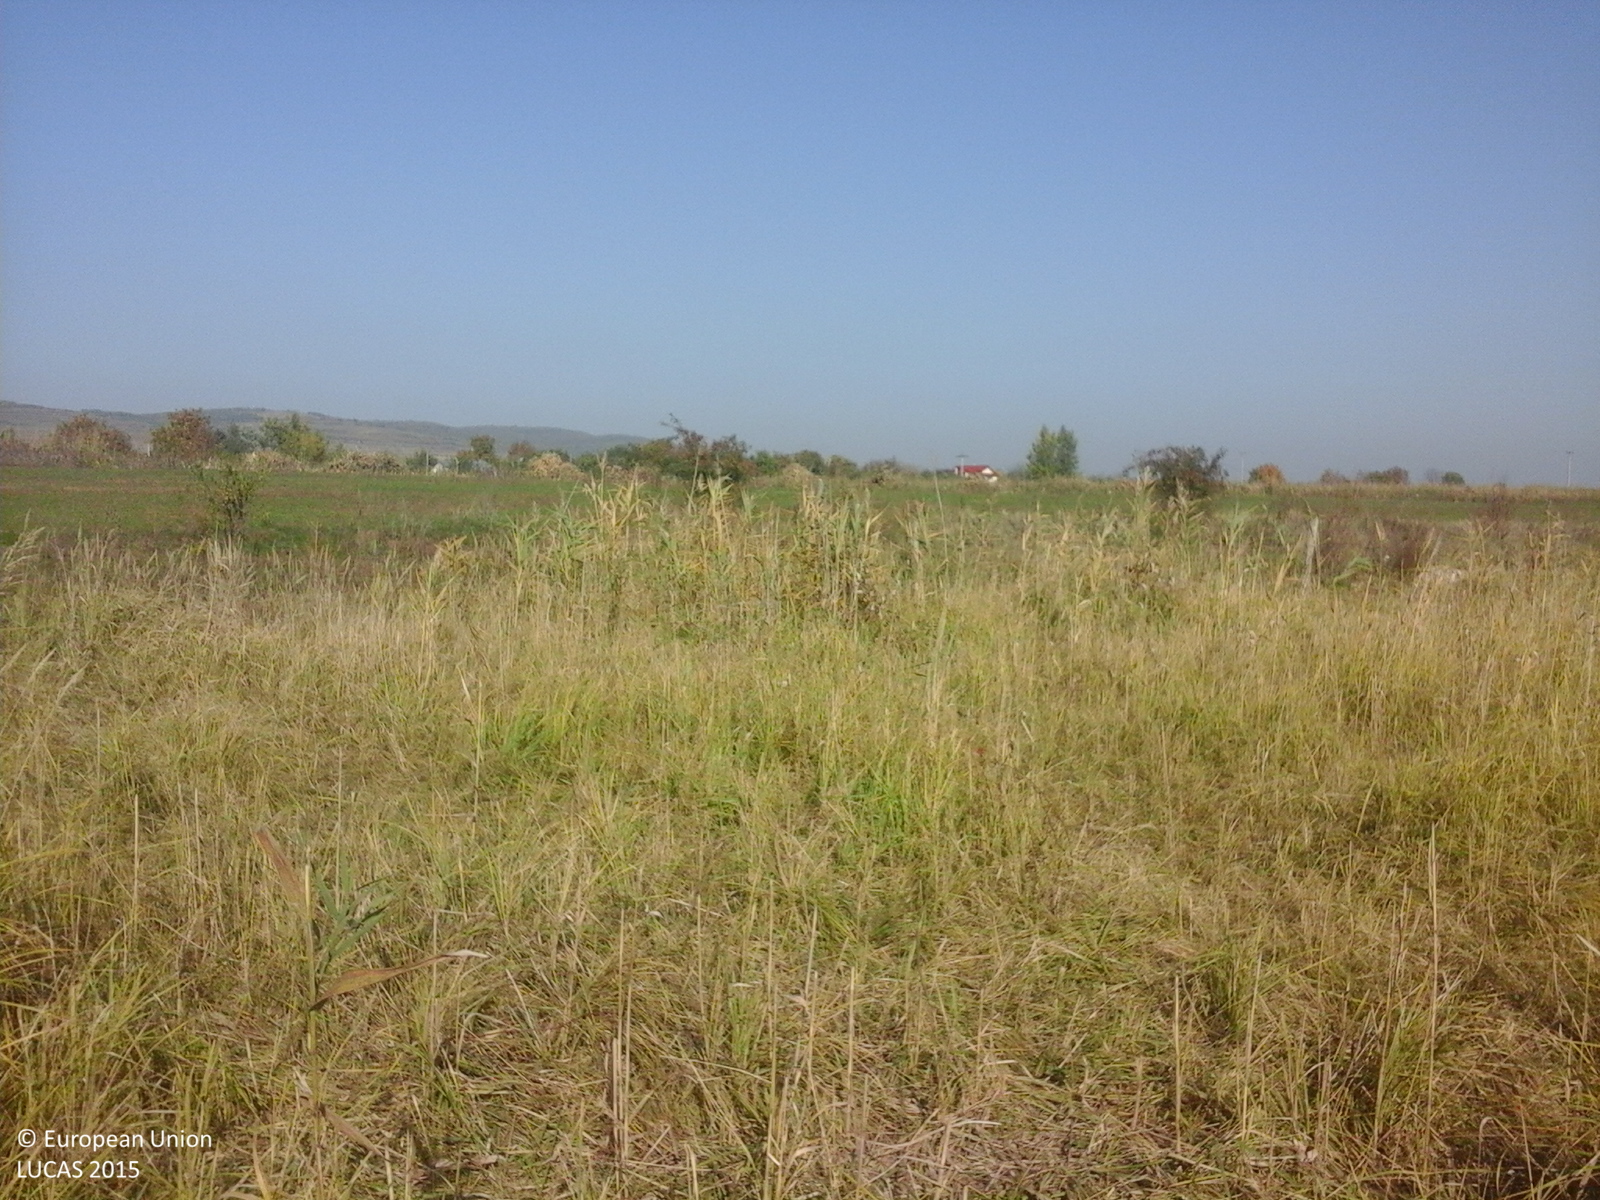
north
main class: Grassland
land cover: Spontaneously vegetated surfaces
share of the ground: > 75 %
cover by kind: herbaceous plants 100 %
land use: Fallow land
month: October
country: RO
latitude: 45.1062
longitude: 26.6609
